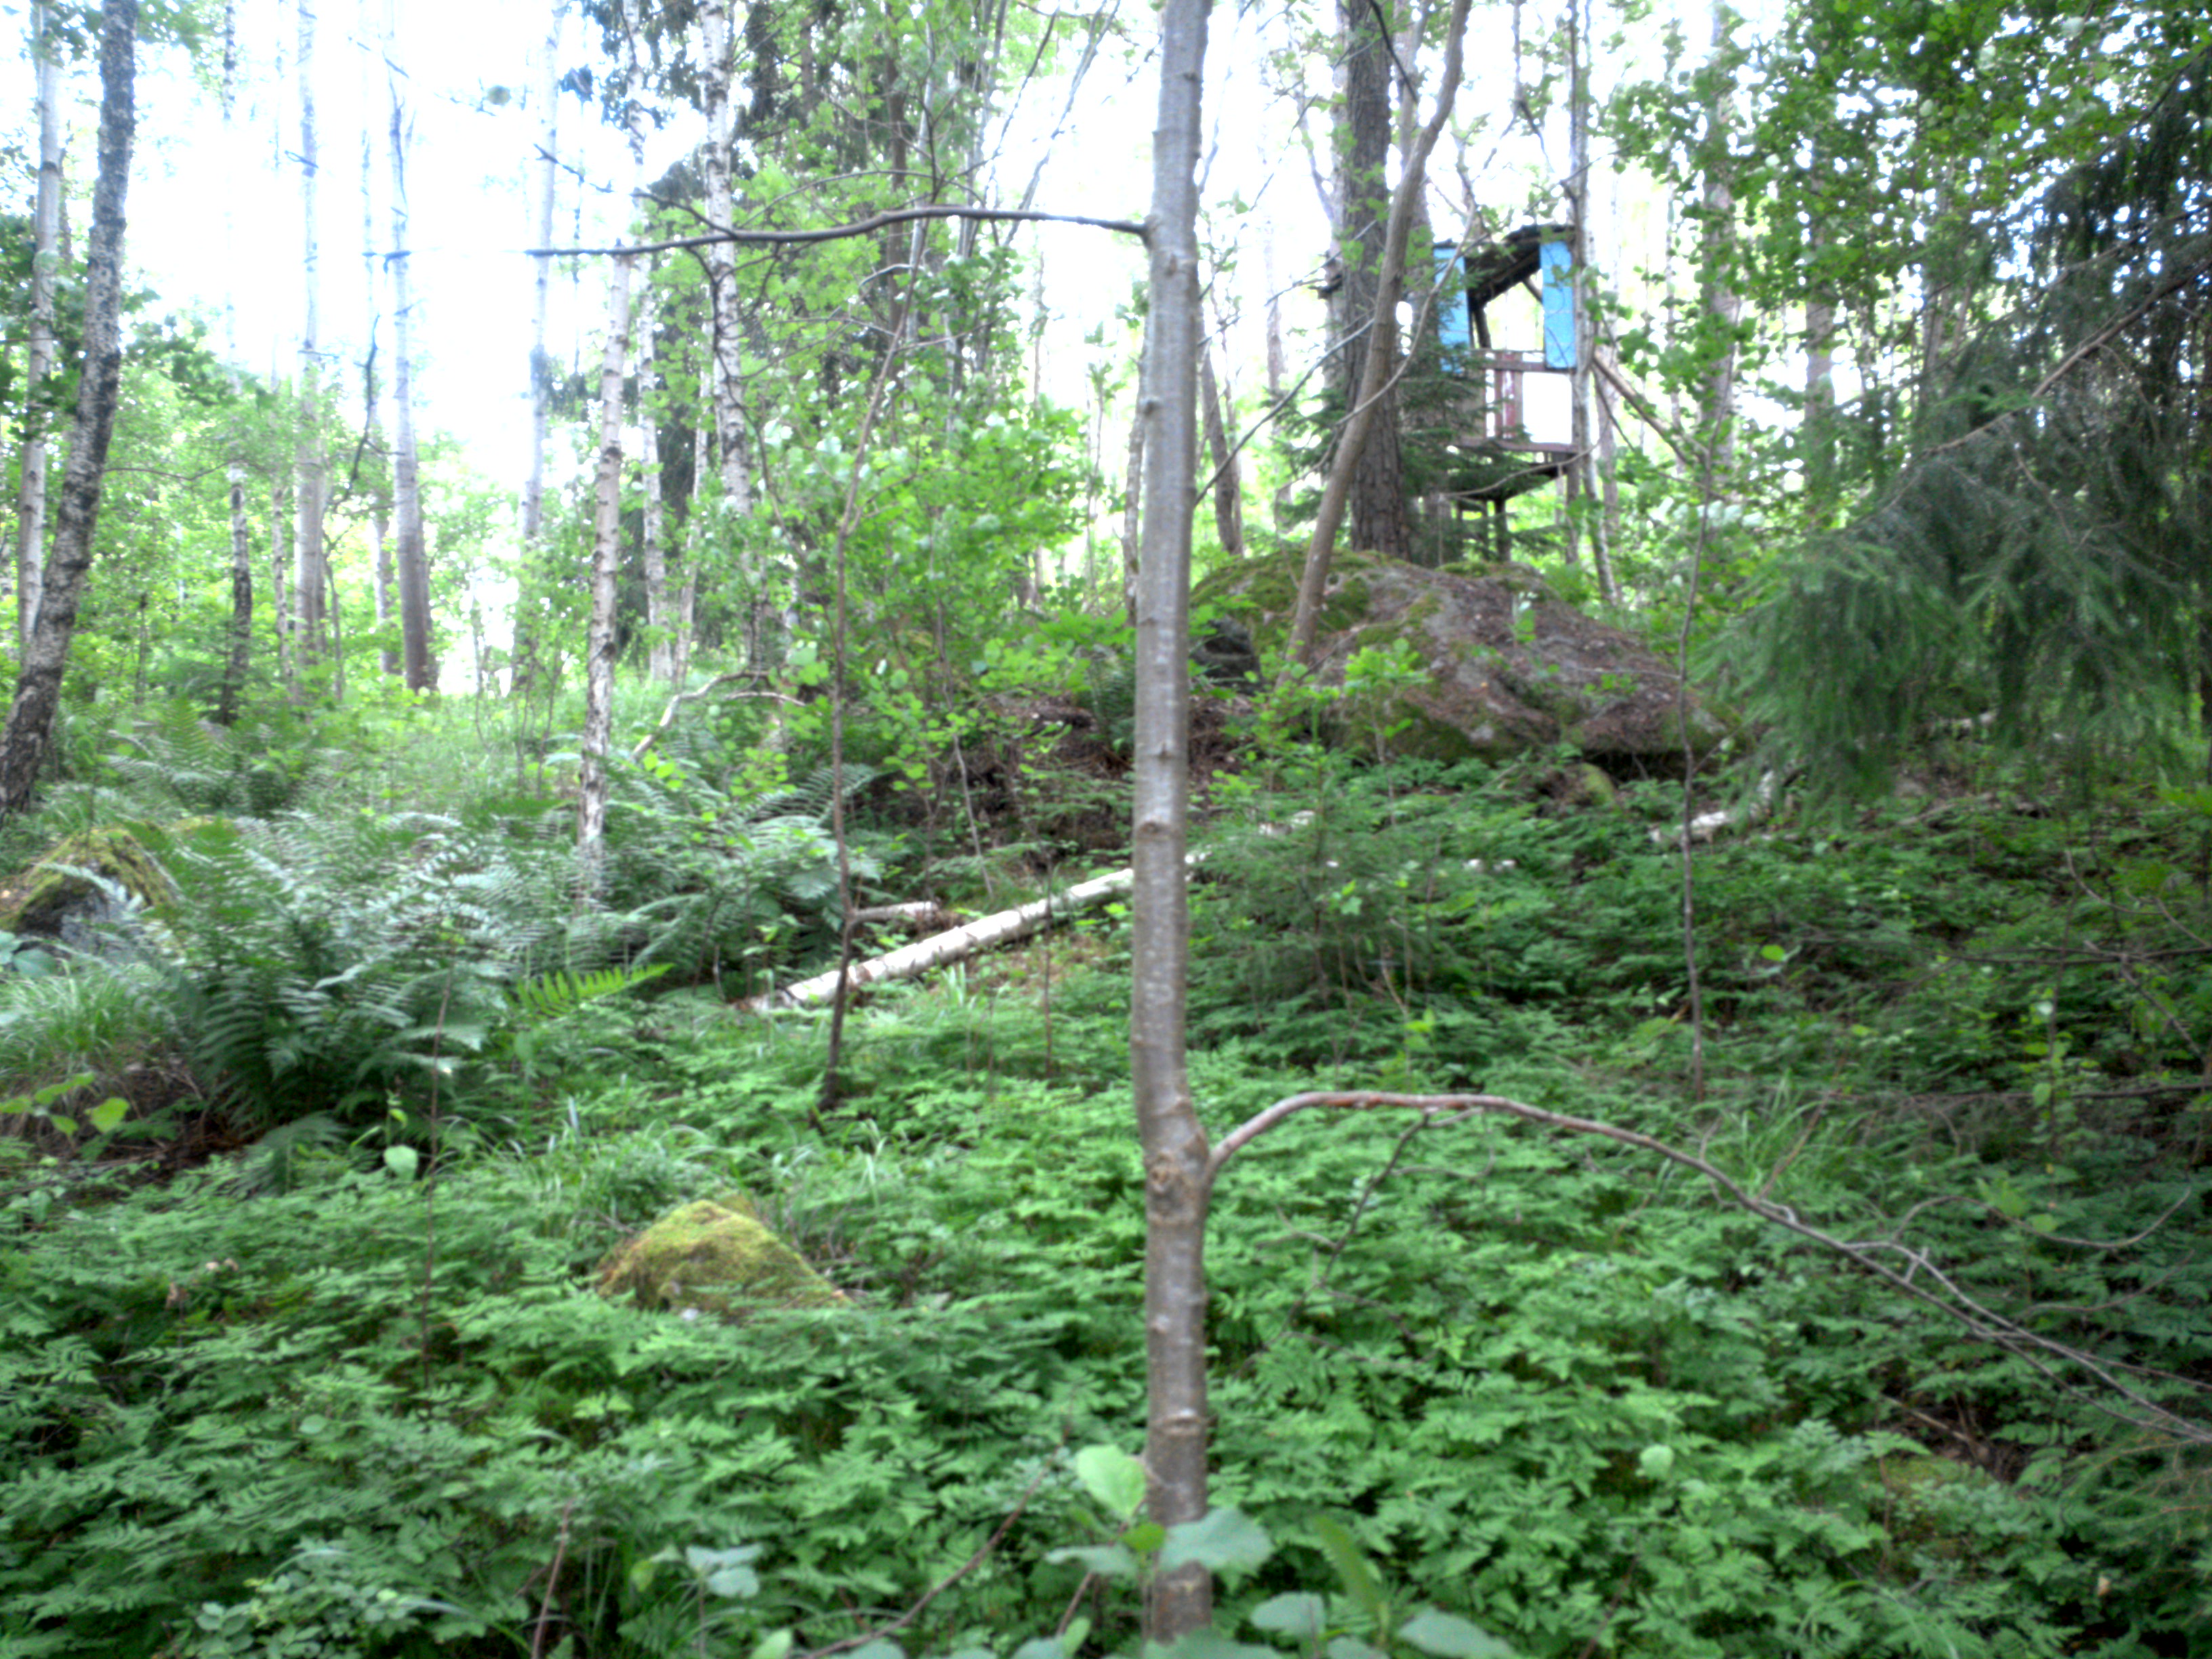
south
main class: Woodland
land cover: Broadleaved woodland
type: non-riverine alder, birch or aspen forest
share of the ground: 50 - 75 %
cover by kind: broadleaved forest trees 70 %, coniferous forest trees 10 %, shrubs 10 %, herbaceous plants 5 %, lichens and mosses 5 %
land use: Forestry
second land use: Amenities, museums, leisure
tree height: > 5 m
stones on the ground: < 10 %
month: June
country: SE
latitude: 59.2071
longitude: 17.7559
